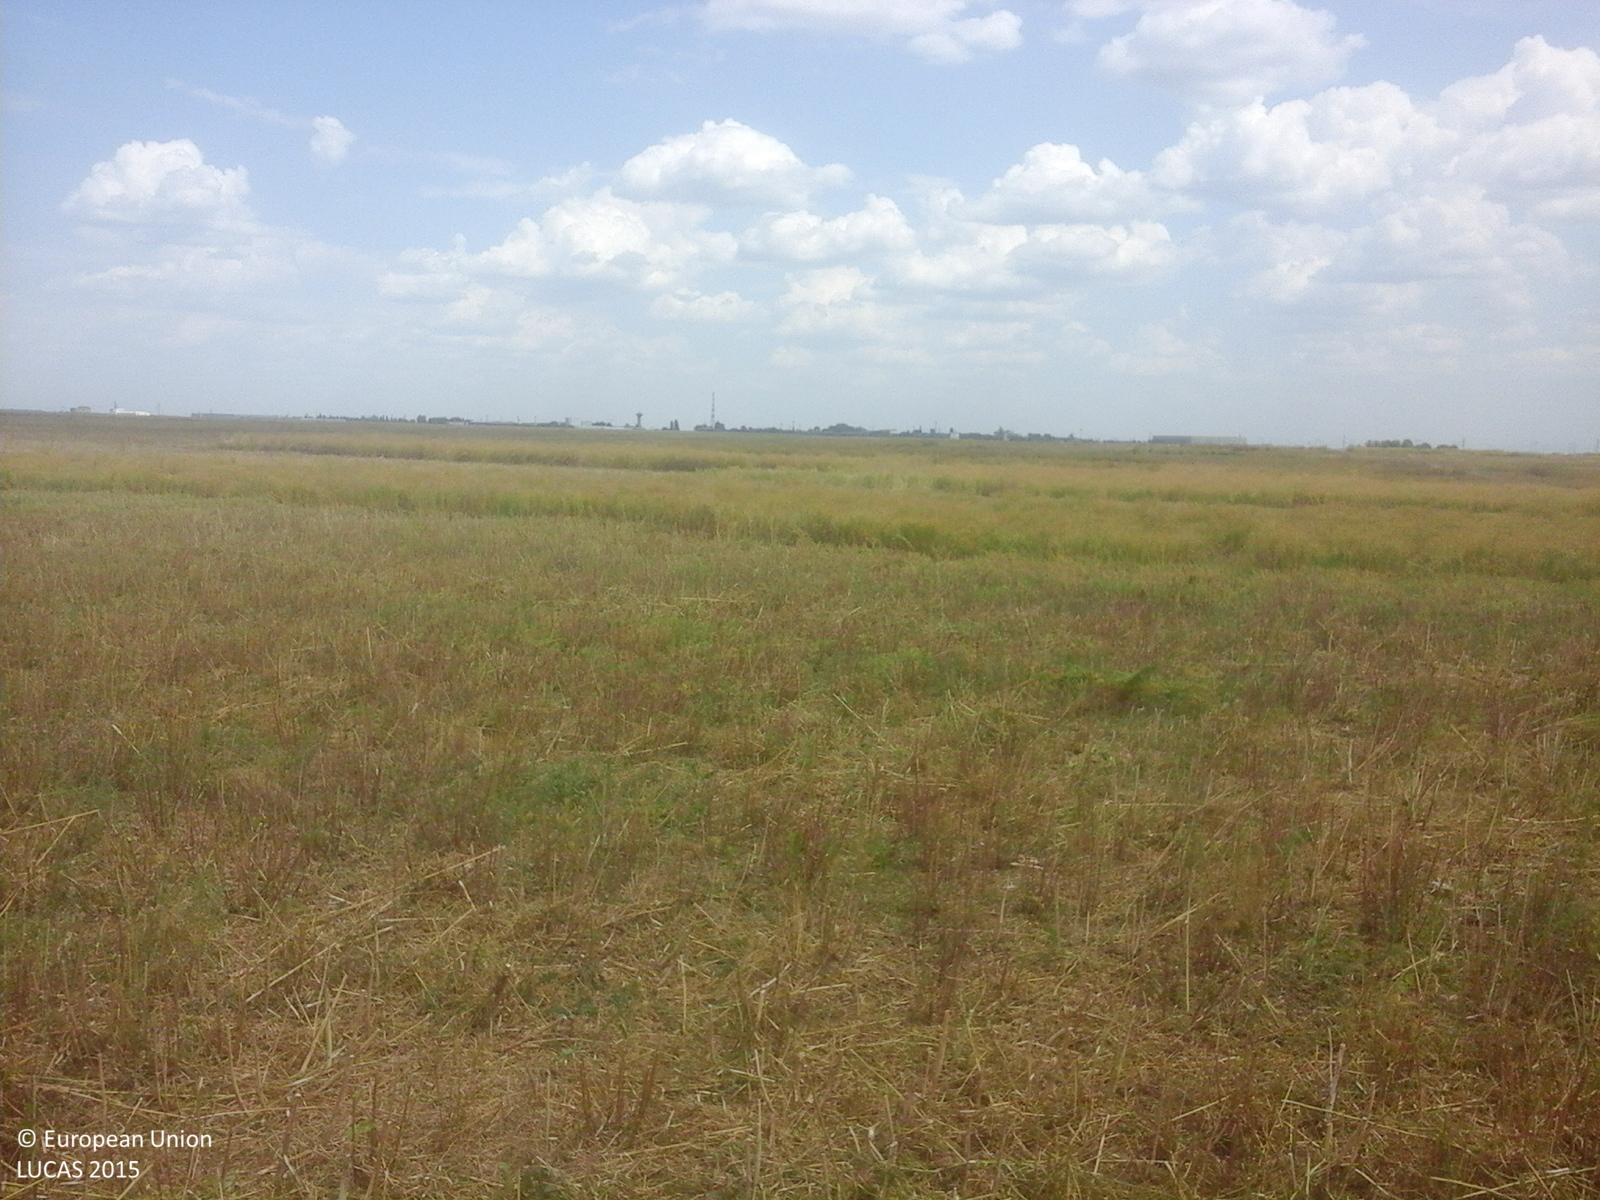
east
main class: Cropland
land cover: Other leguminous and mixtures for fodder
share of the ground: > 75 %
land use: Agriculture (excluding fallow land and kitchen gardens)
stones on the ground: < 10 %
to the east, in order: Other leguminous and mixtures for fodder
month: June
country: RO
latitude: 44.3467
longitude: 26.1236
